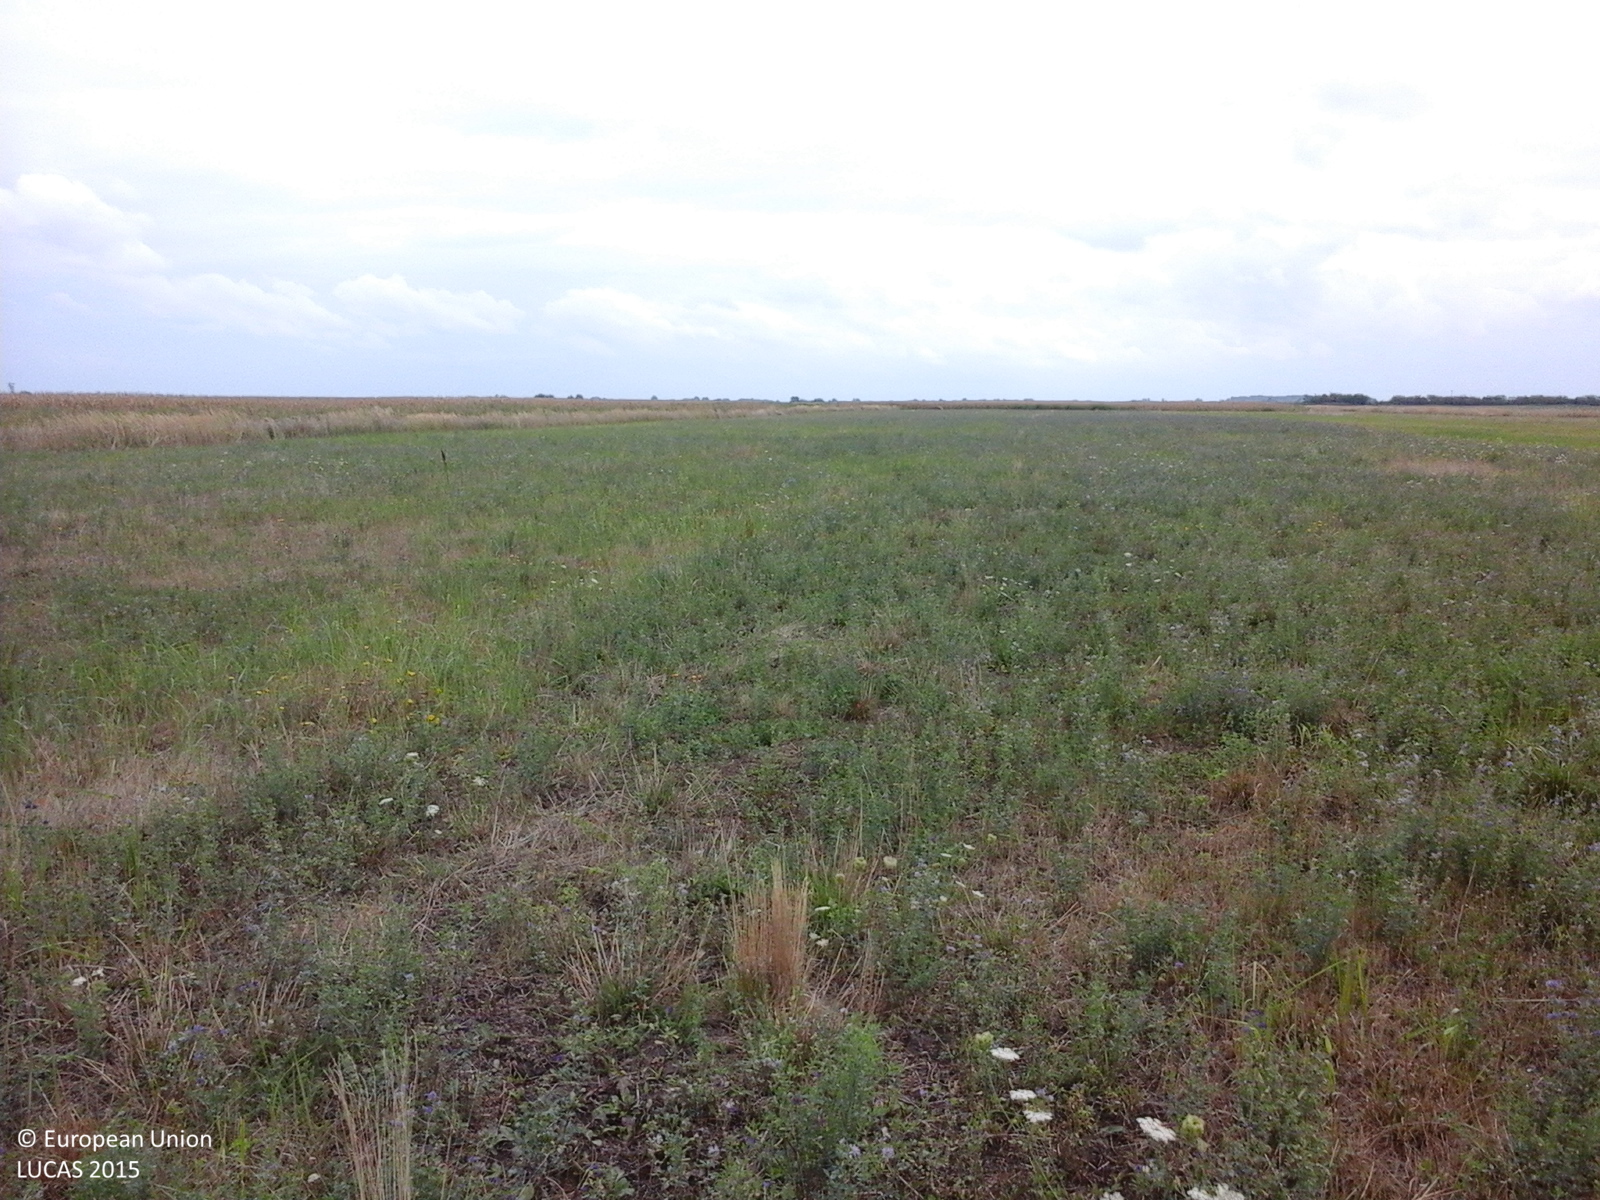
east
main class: Cropland
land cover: Other leguminous and mixtures for fodder
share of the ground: > 75 %
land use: Agriculture (excluding fallow land and kitchen gardens)
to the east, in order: Other leguminous and mixtures for fodder
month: August
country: RO
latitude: 45.3159
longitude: 21.1119
